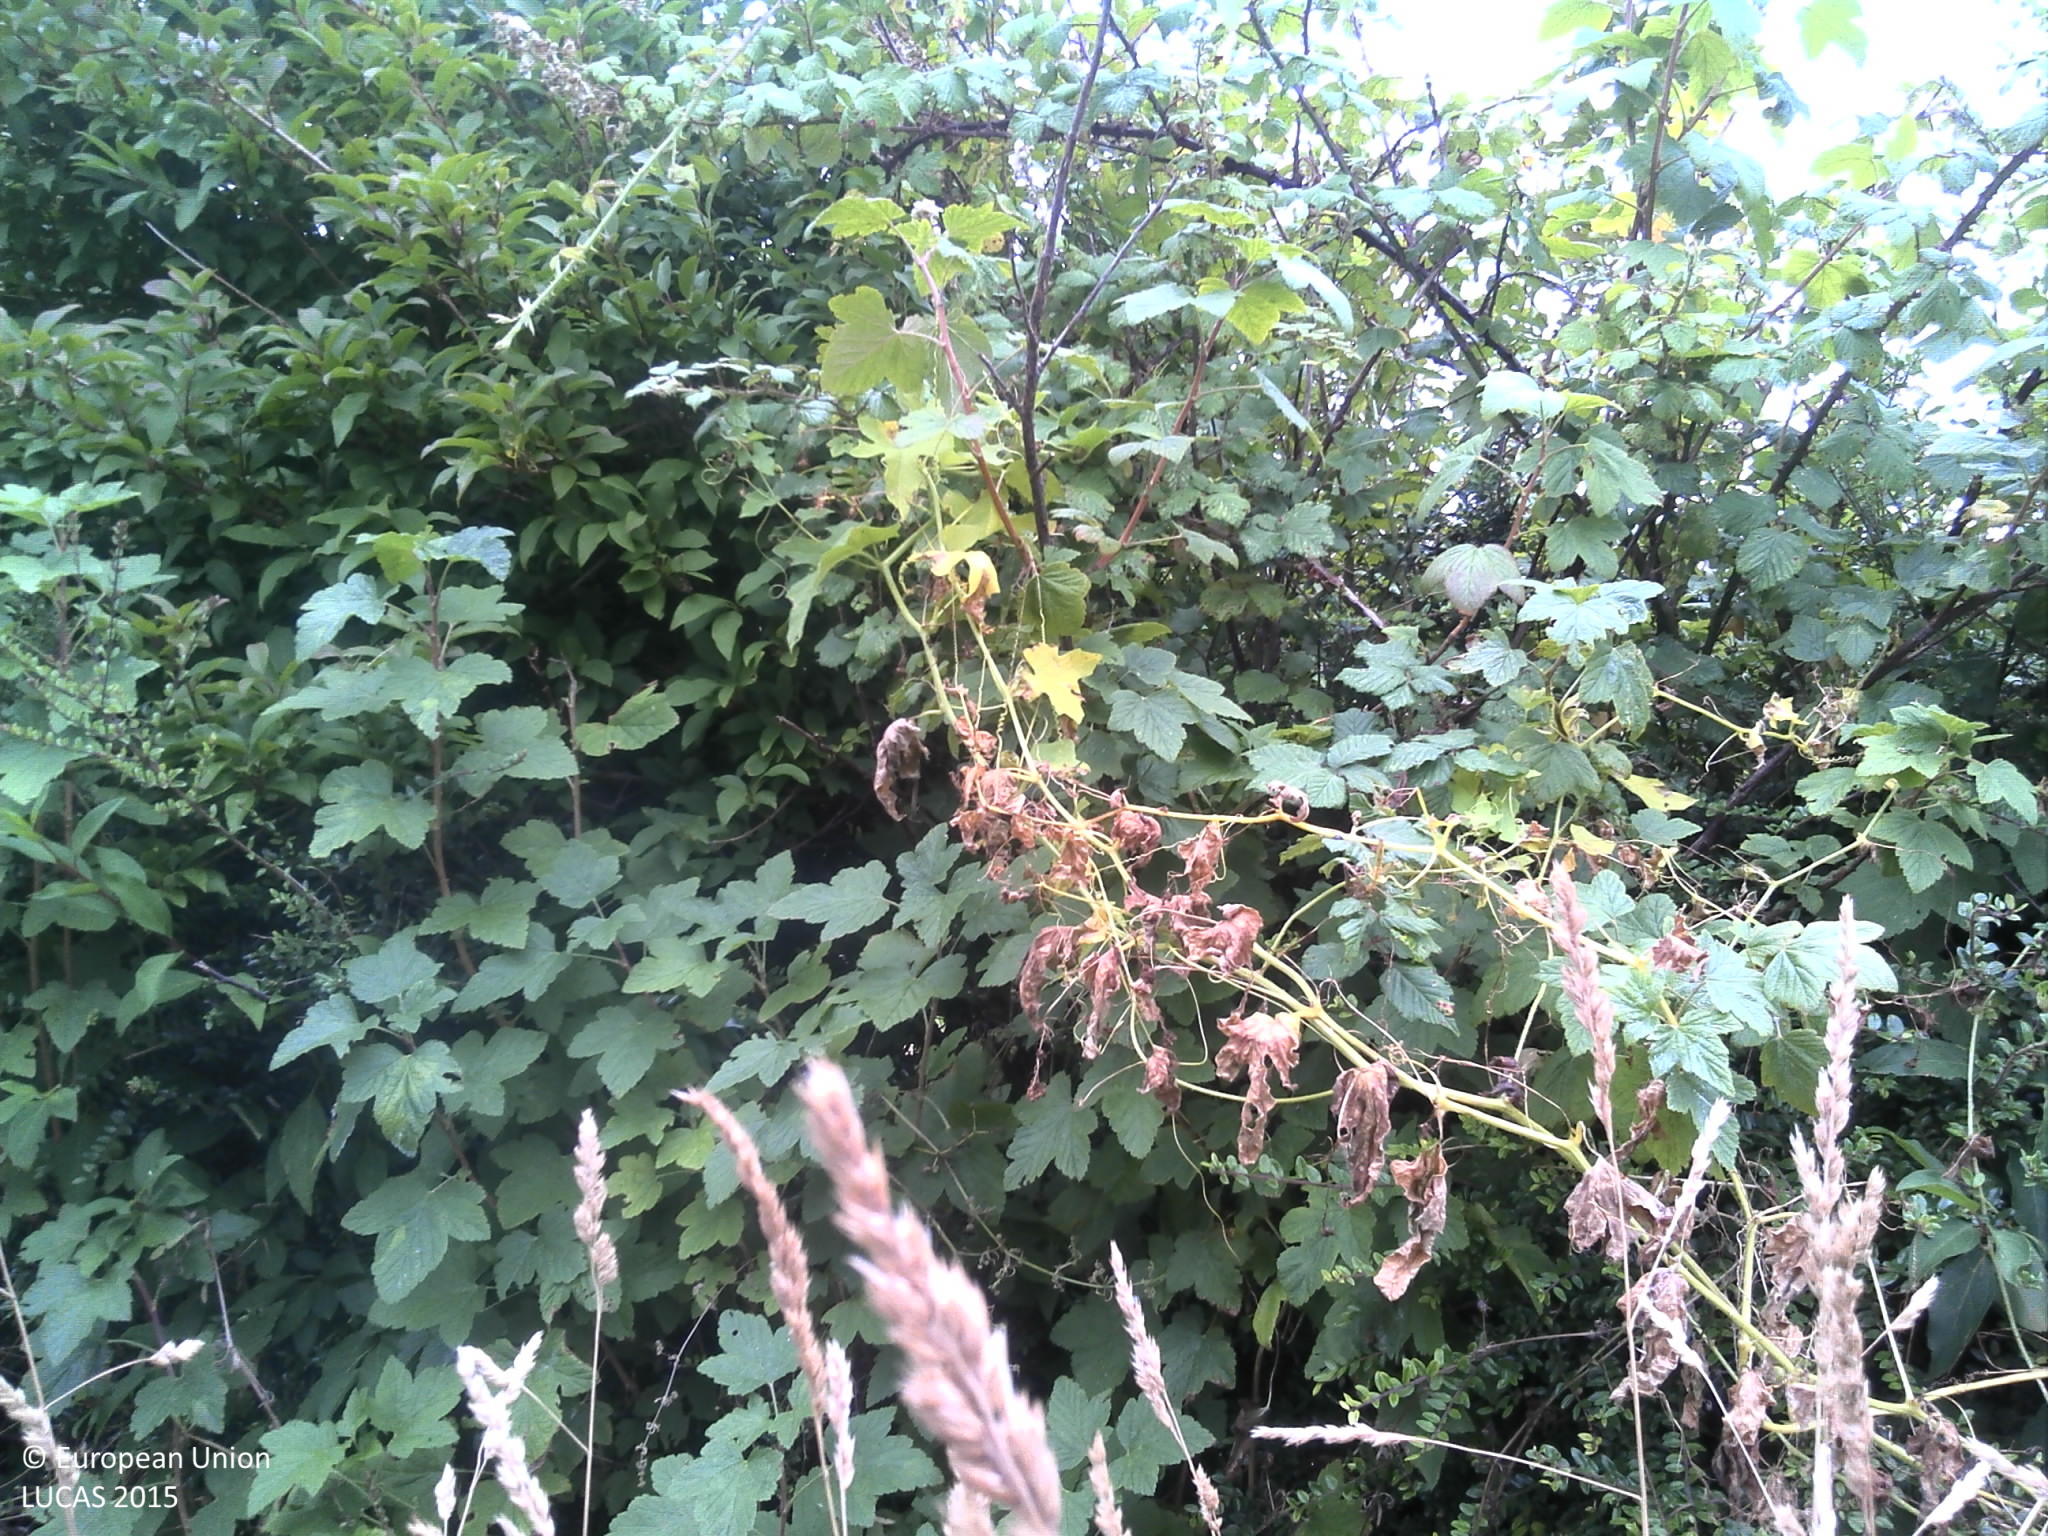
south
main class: Shrubland
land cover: Shrubland without tree cover
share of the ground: > 75 %
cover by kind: shrubs 80 %, herbaceous plants 20 %
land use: Semi-natural and natural areas not in use
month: July
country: FR
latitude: 48.3449
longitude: -4.4397
